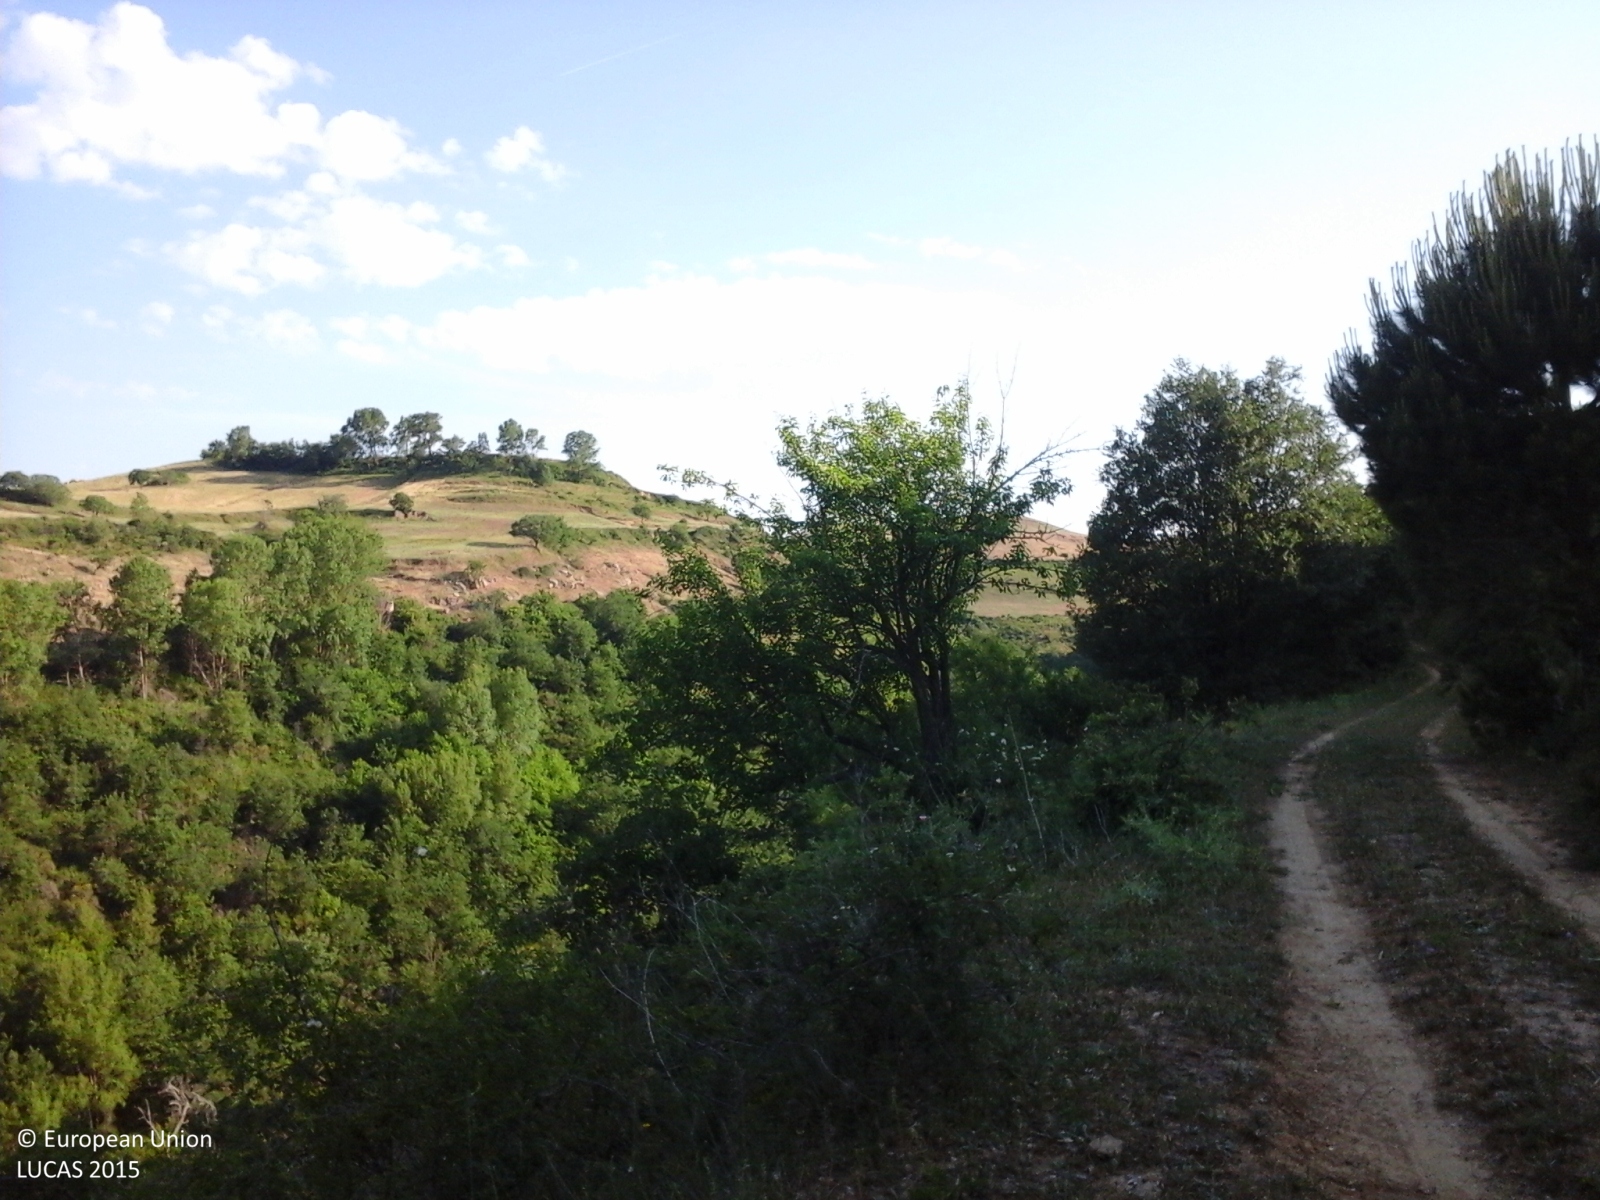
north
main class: Woodland
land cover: Broadleaved woodland
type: broadleaved evergreen forest
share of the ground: > 75 %
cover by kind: broadleaved forest trees 90 %, shrubs 10 %
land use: Forestry
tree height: > 5 m
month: June
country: IT
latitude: 37.3909
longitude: 14.4059
